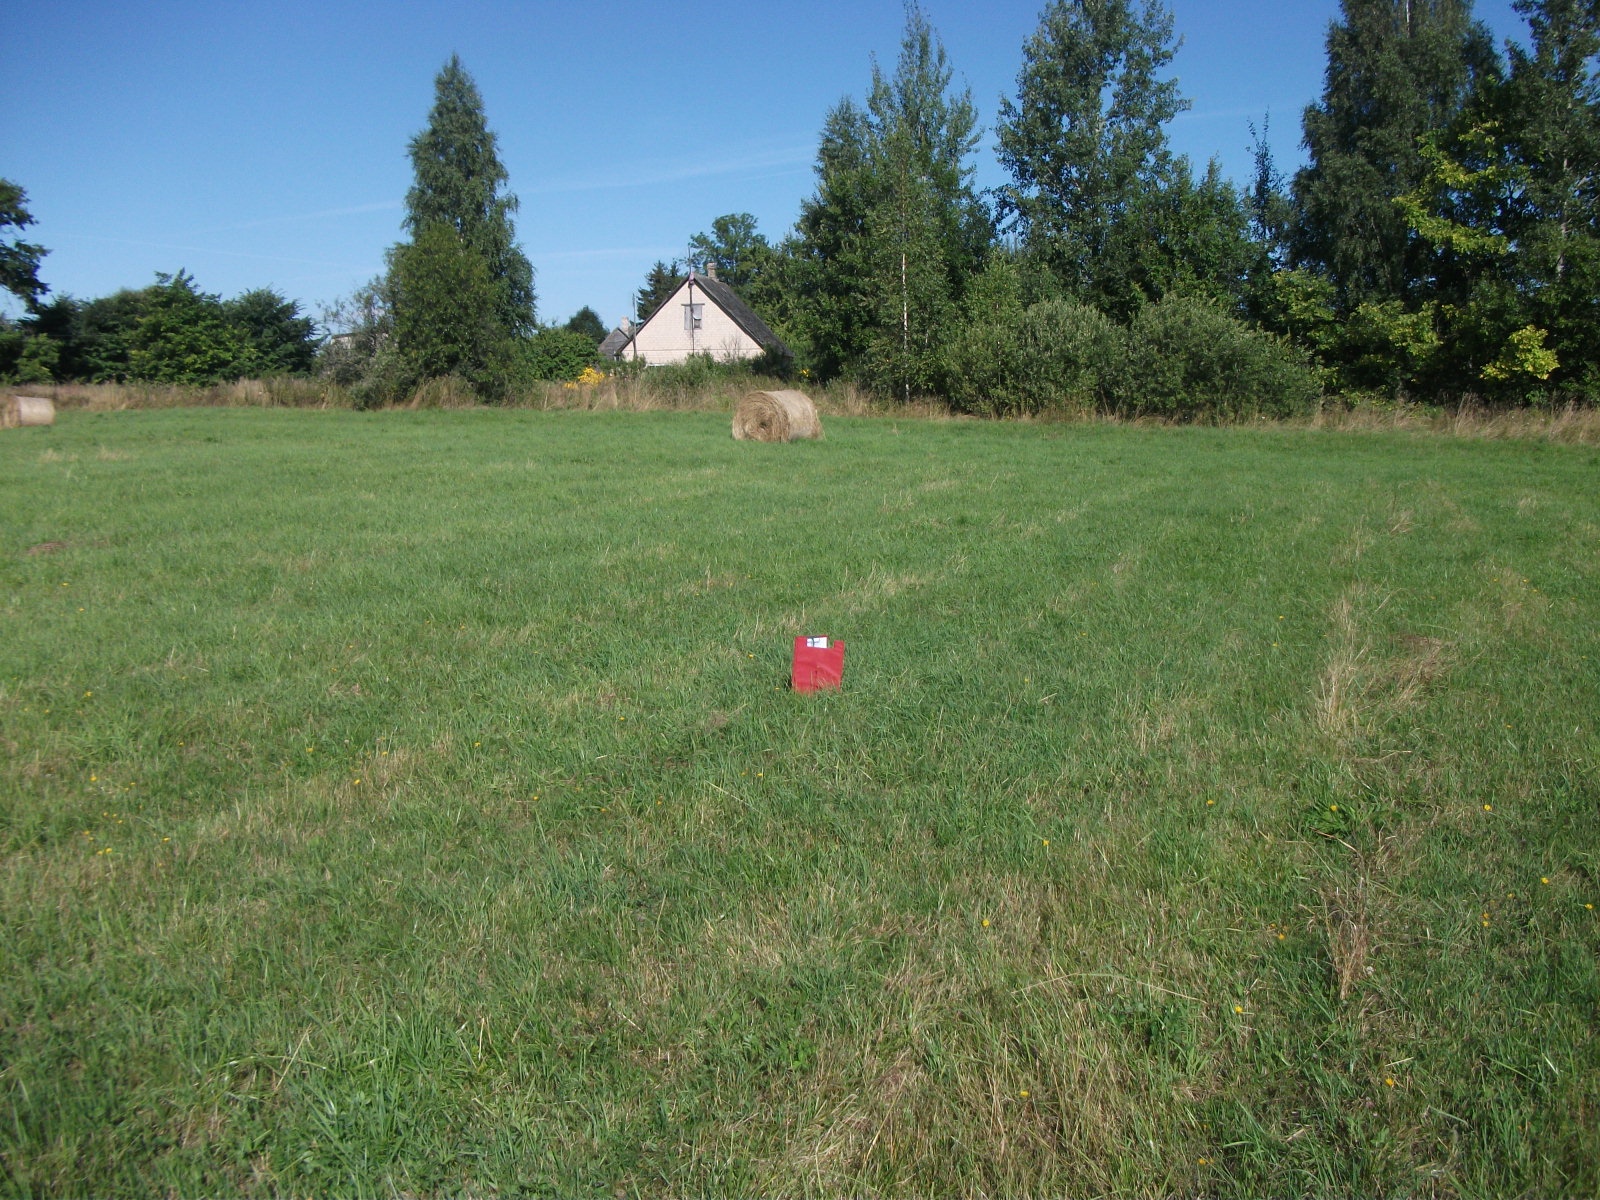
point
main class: Grassland
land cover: Grassland without tree/shrub cover
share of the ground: > 75 %
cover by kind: herbaceous plants 100 %
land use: Agriculture (excluding fallow land and kitchen gardens)
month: August
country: LV
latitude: 56.3304
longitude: 26.2998
